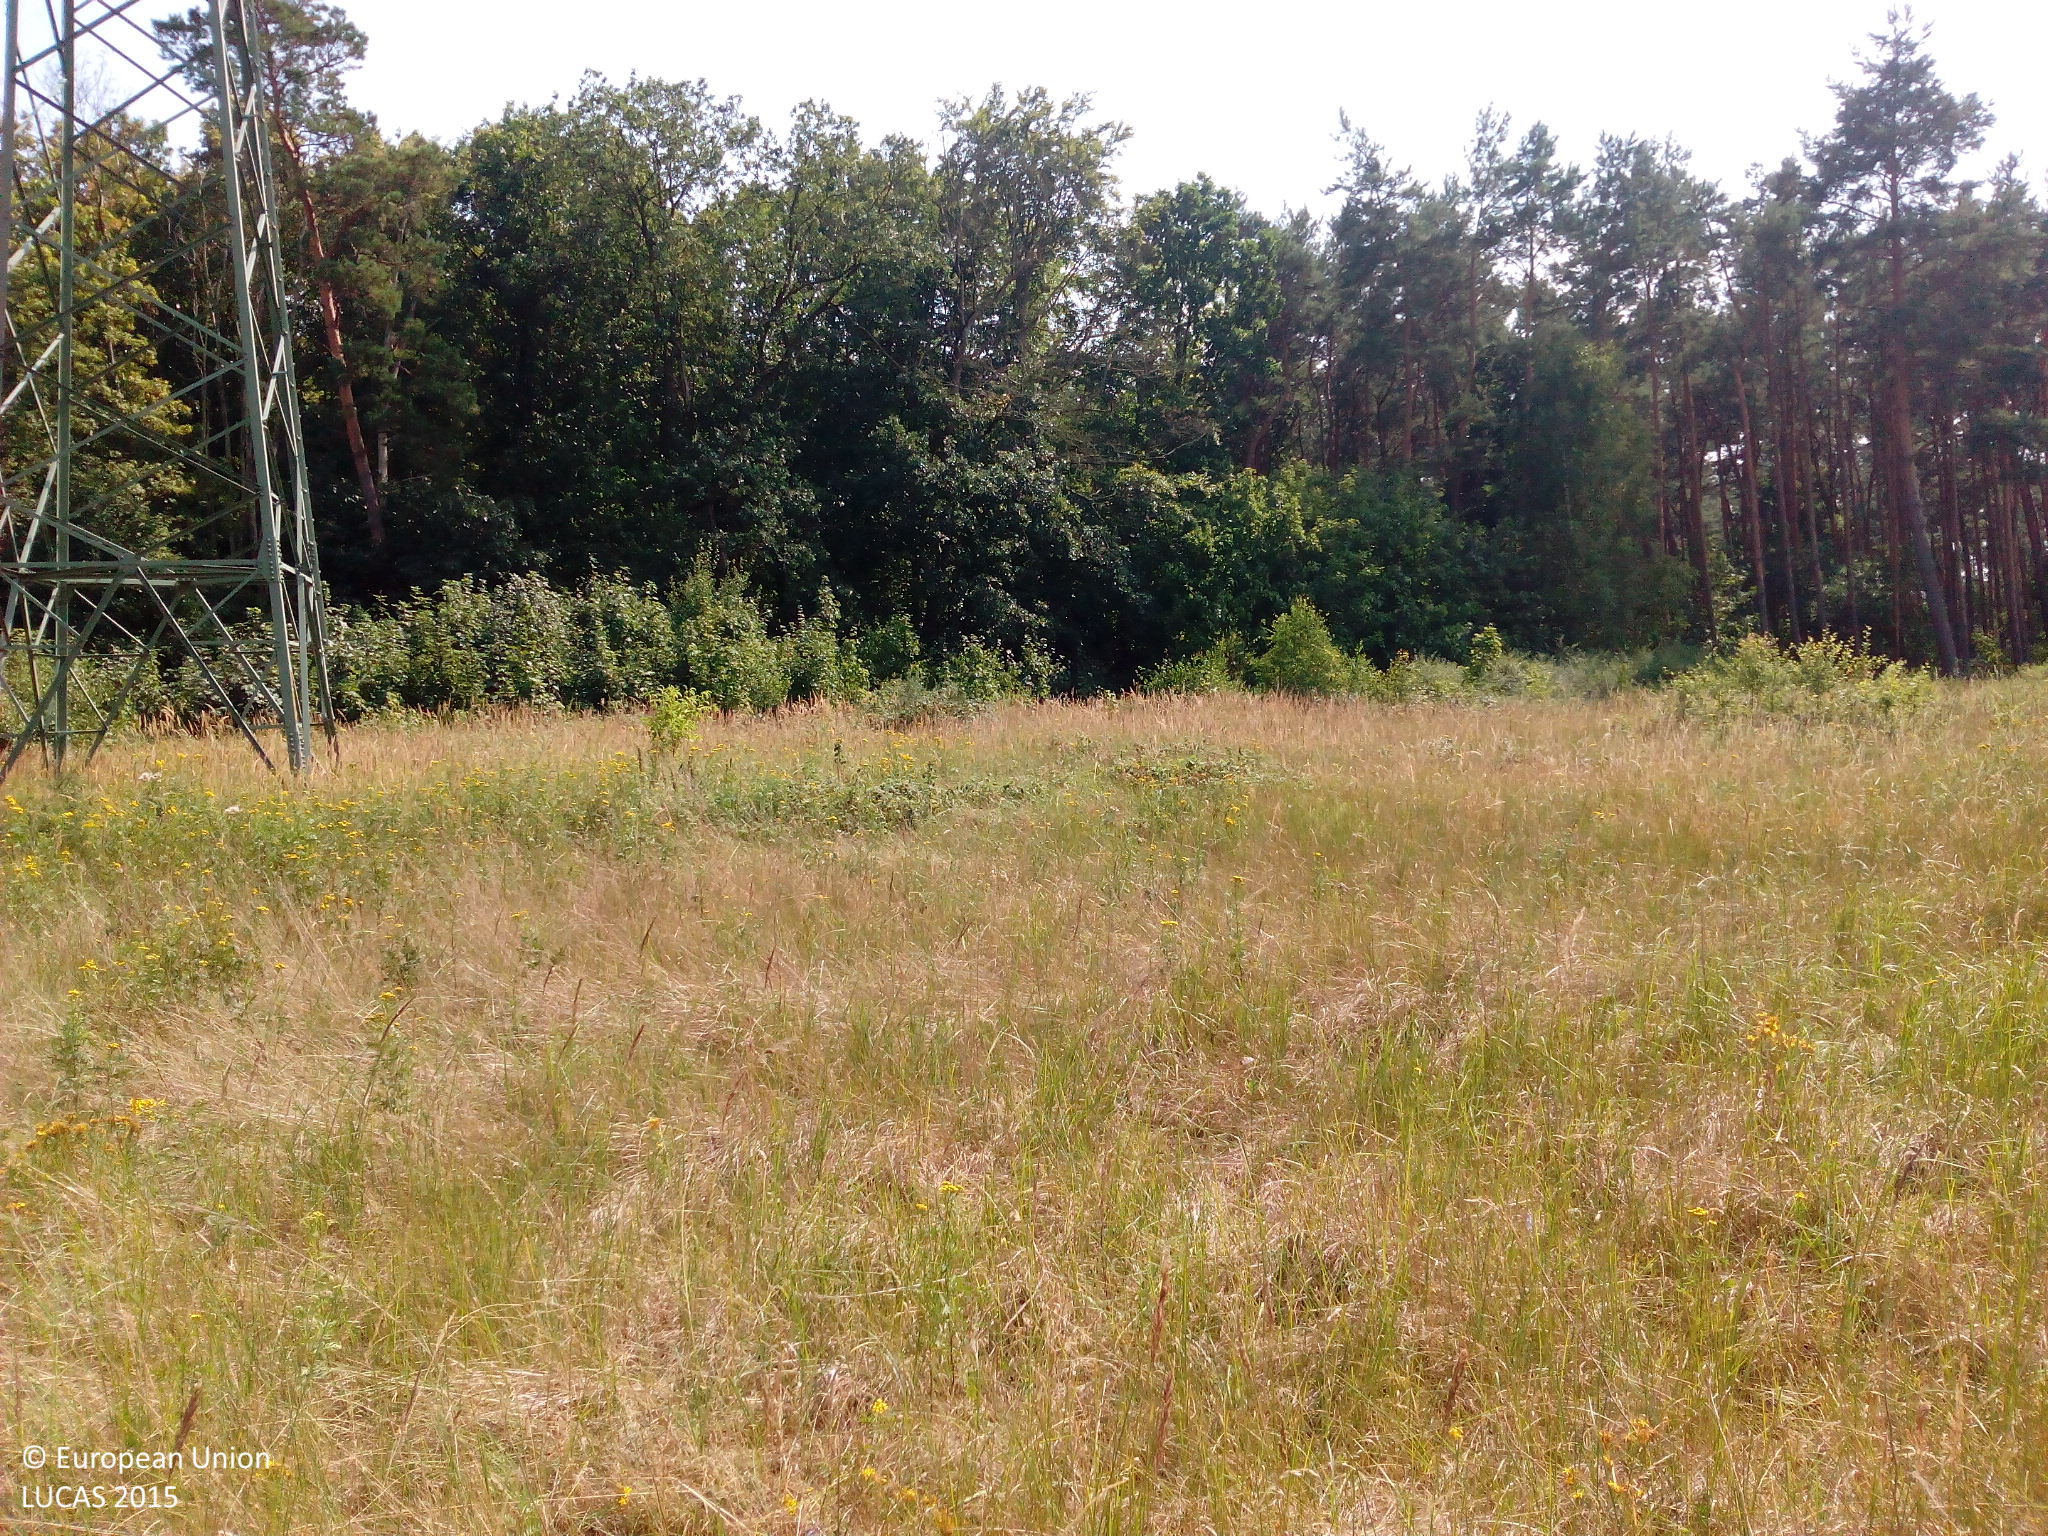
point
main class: Woodland
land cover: Pine dominated mixed woodland
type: hemiboreal forest and nemoral coniferous forest and mixed broadleaved-coniferous forest
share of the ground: > 75 %
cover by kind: broadleaved forest trees 50 %, coniferous forest trees 40 %, herbaceous plants 5 %, unconsolidated bare surface 5 %
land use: Forestry
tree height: > 5 m
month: August
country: DE
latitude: 53.0752
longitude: 14.2550
